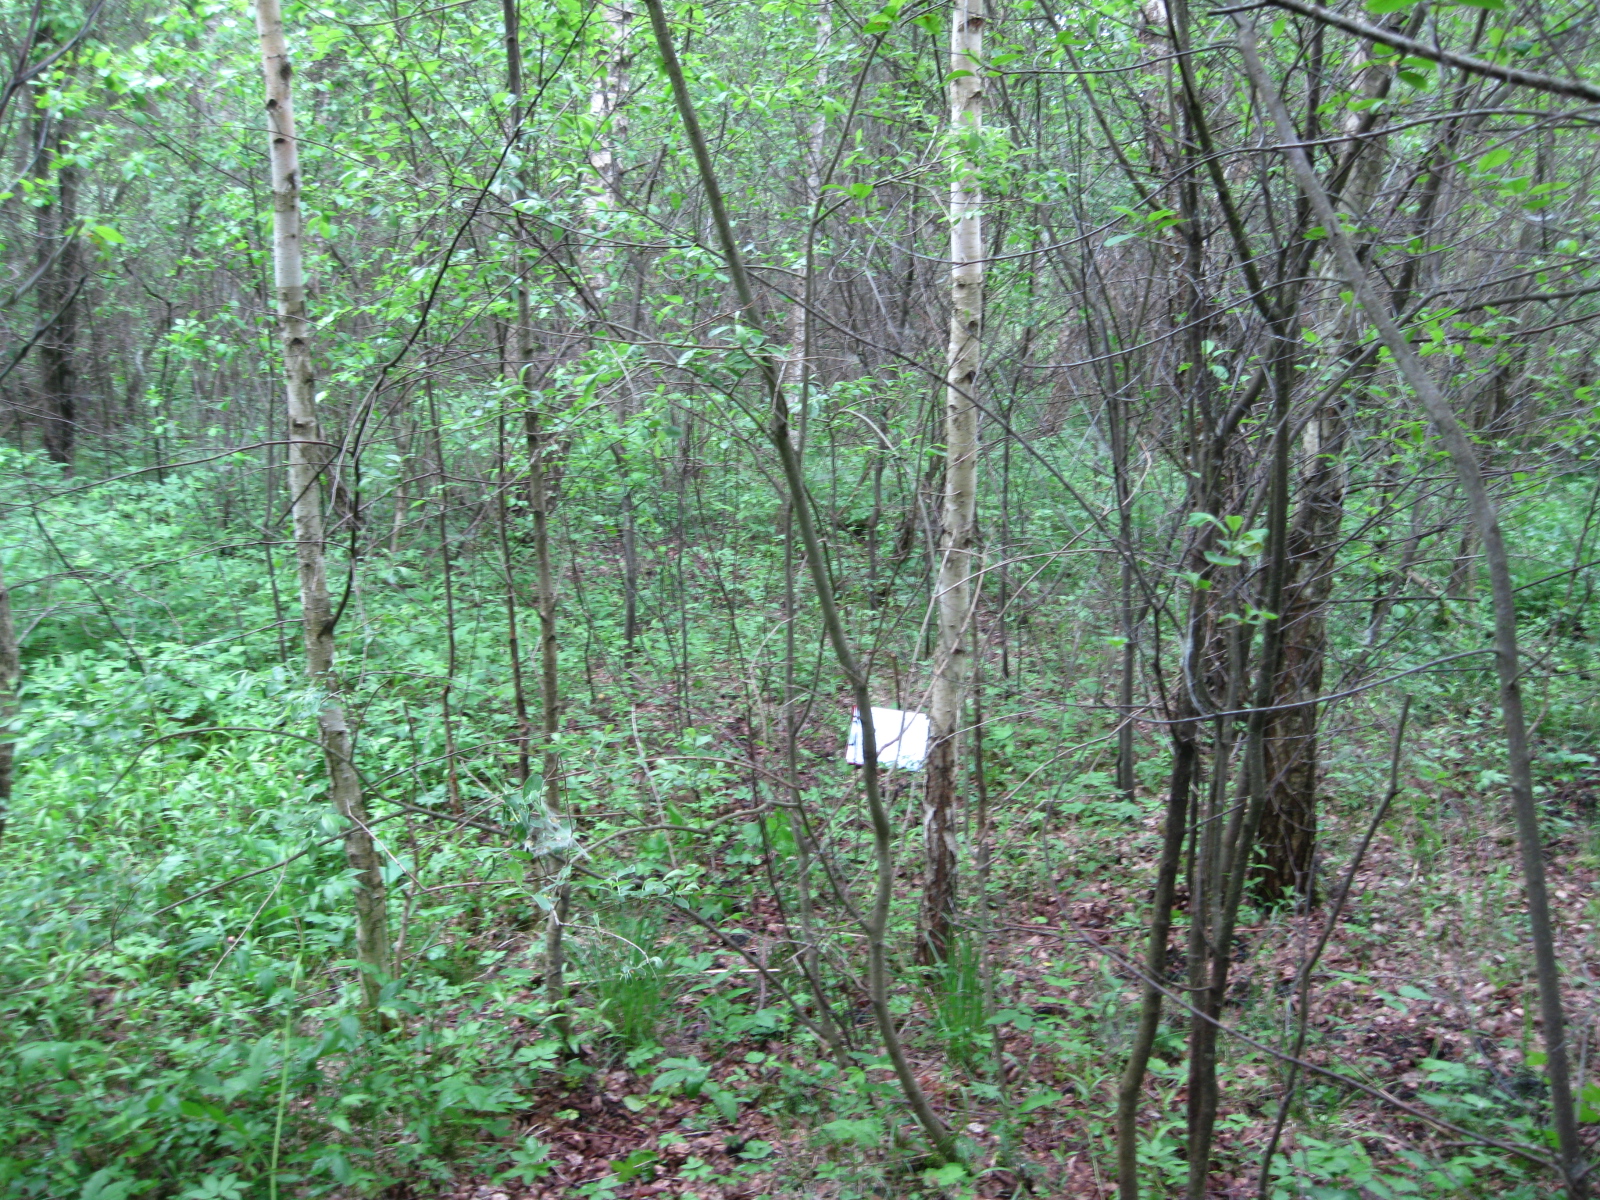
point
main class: Woodland
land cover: Broadleaved woodland
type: non-riverine alder, birch or aspen forest
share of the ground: > 75 %
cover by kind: broadleaved forest trees 80 %, herbaceous plants 15 %, shrubs 5 %
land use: Forestry
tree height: > 5 m
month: June
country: LT
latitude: 55.9169
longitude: 24.0898
